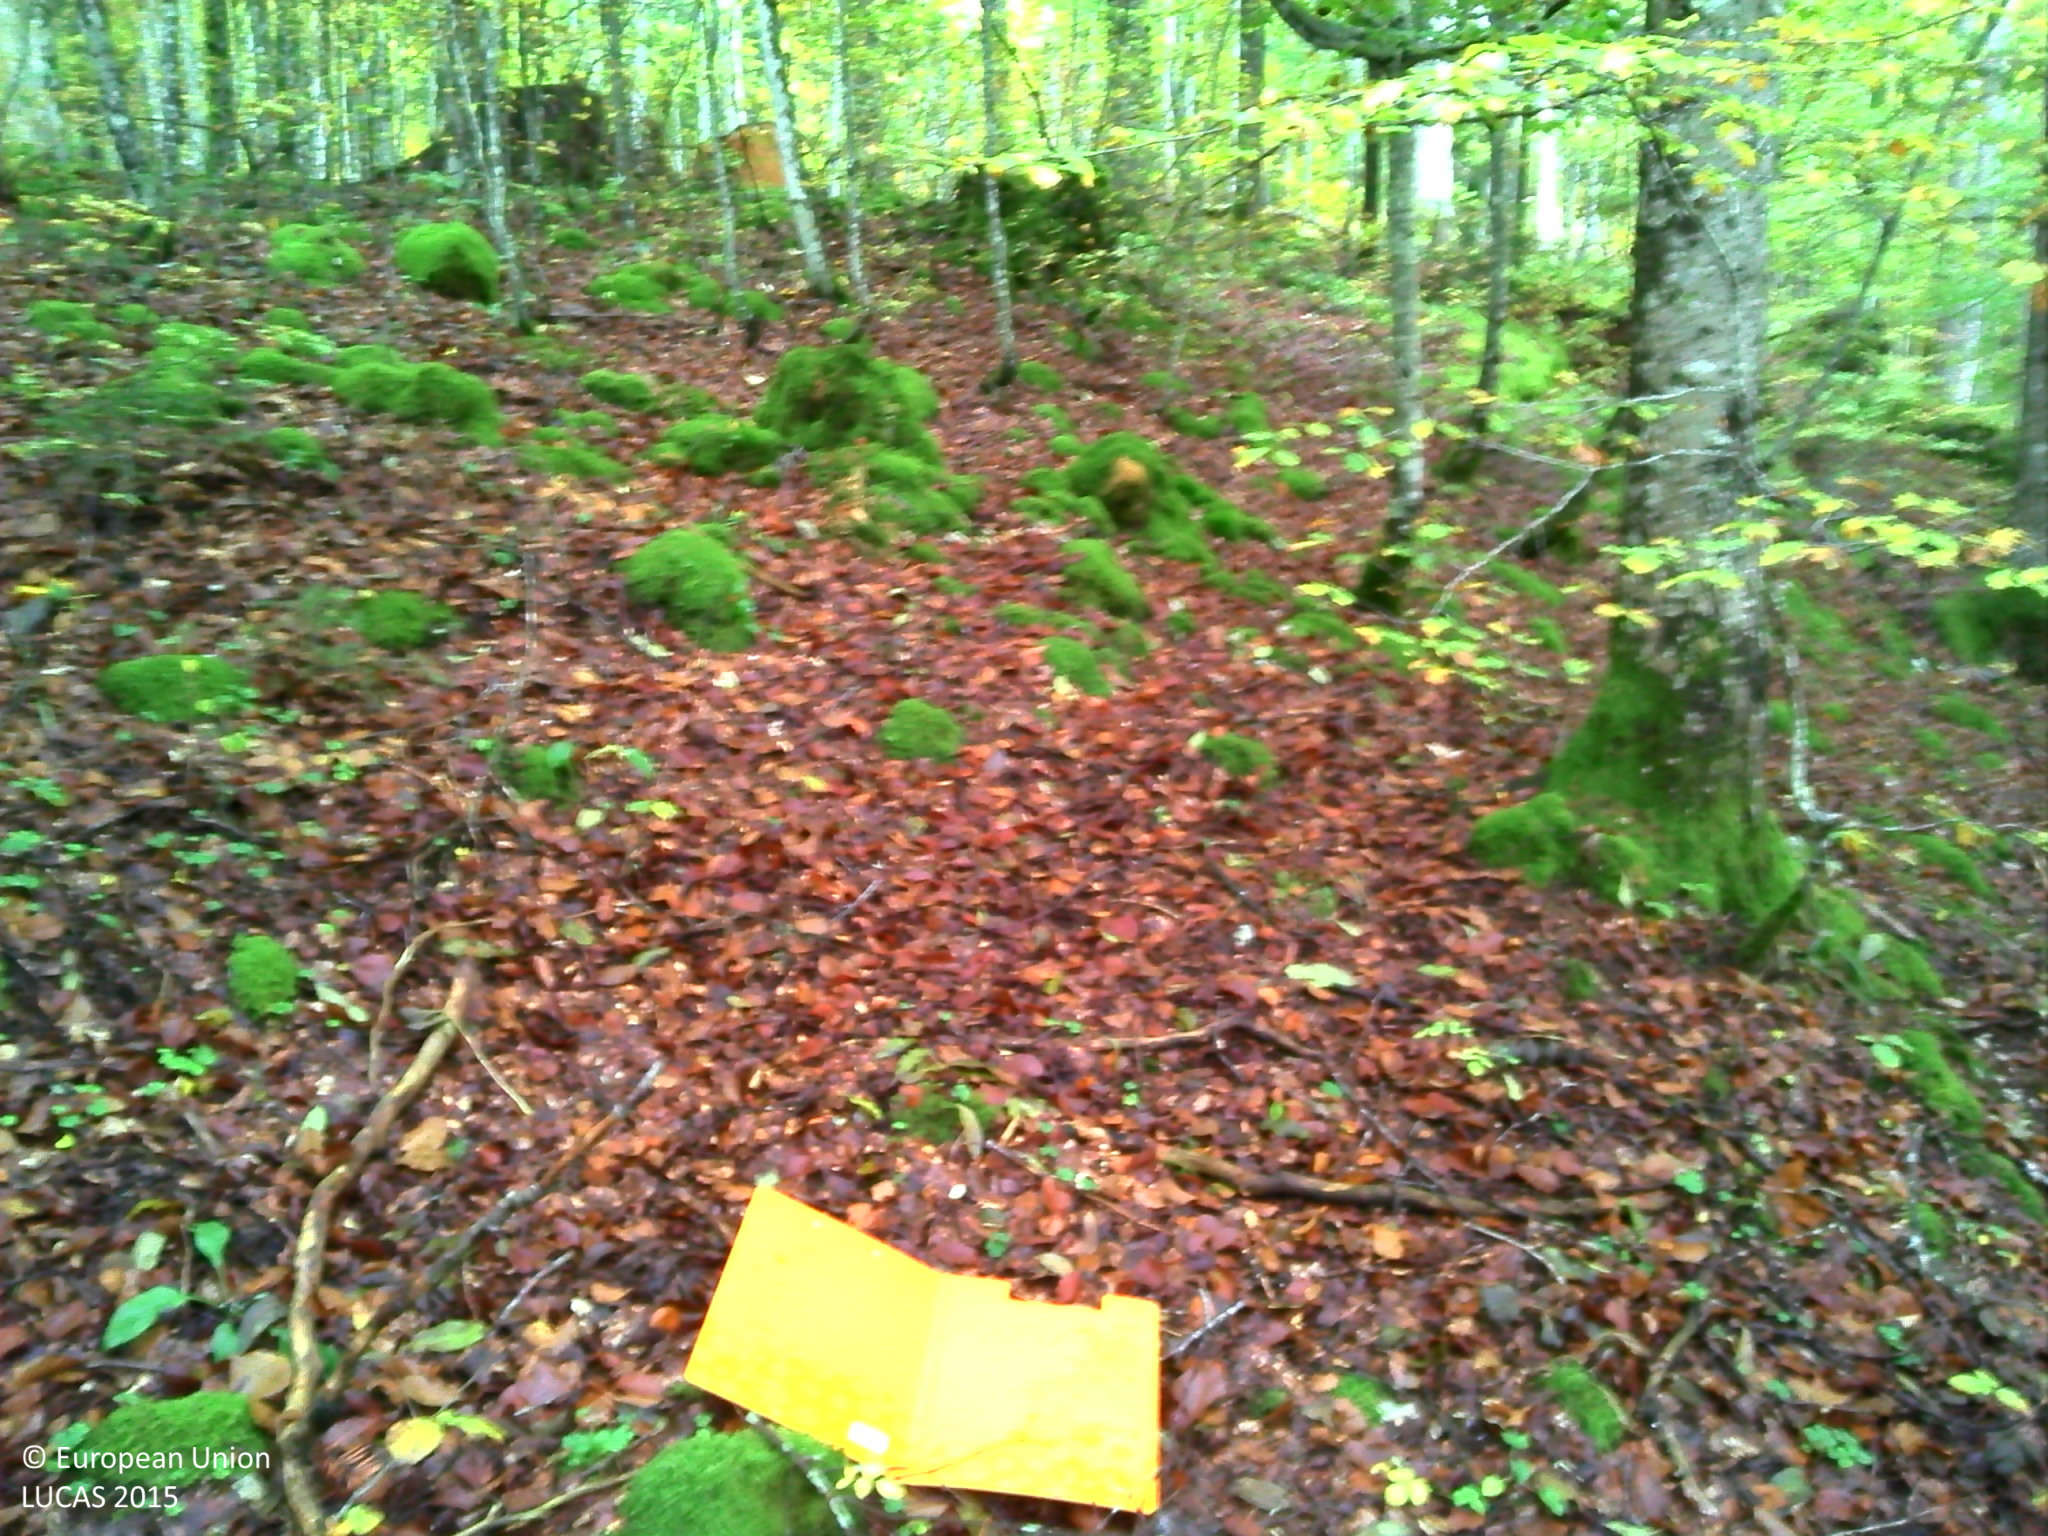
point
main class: Woodland
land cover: Spruce dominated mixed woodland
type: mountainous beech forest
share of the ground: 50 - 75 %
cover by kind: broadleaved forest trees 40 %, coniferous forest trees 30 %, unconsolidated bare surface 20 %, lichens and mosses 5 %, consolidated bare surface 5 %
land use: Forestry
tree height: > 5 m
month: October
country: FR
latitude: 46.7594
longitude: 6.4022
